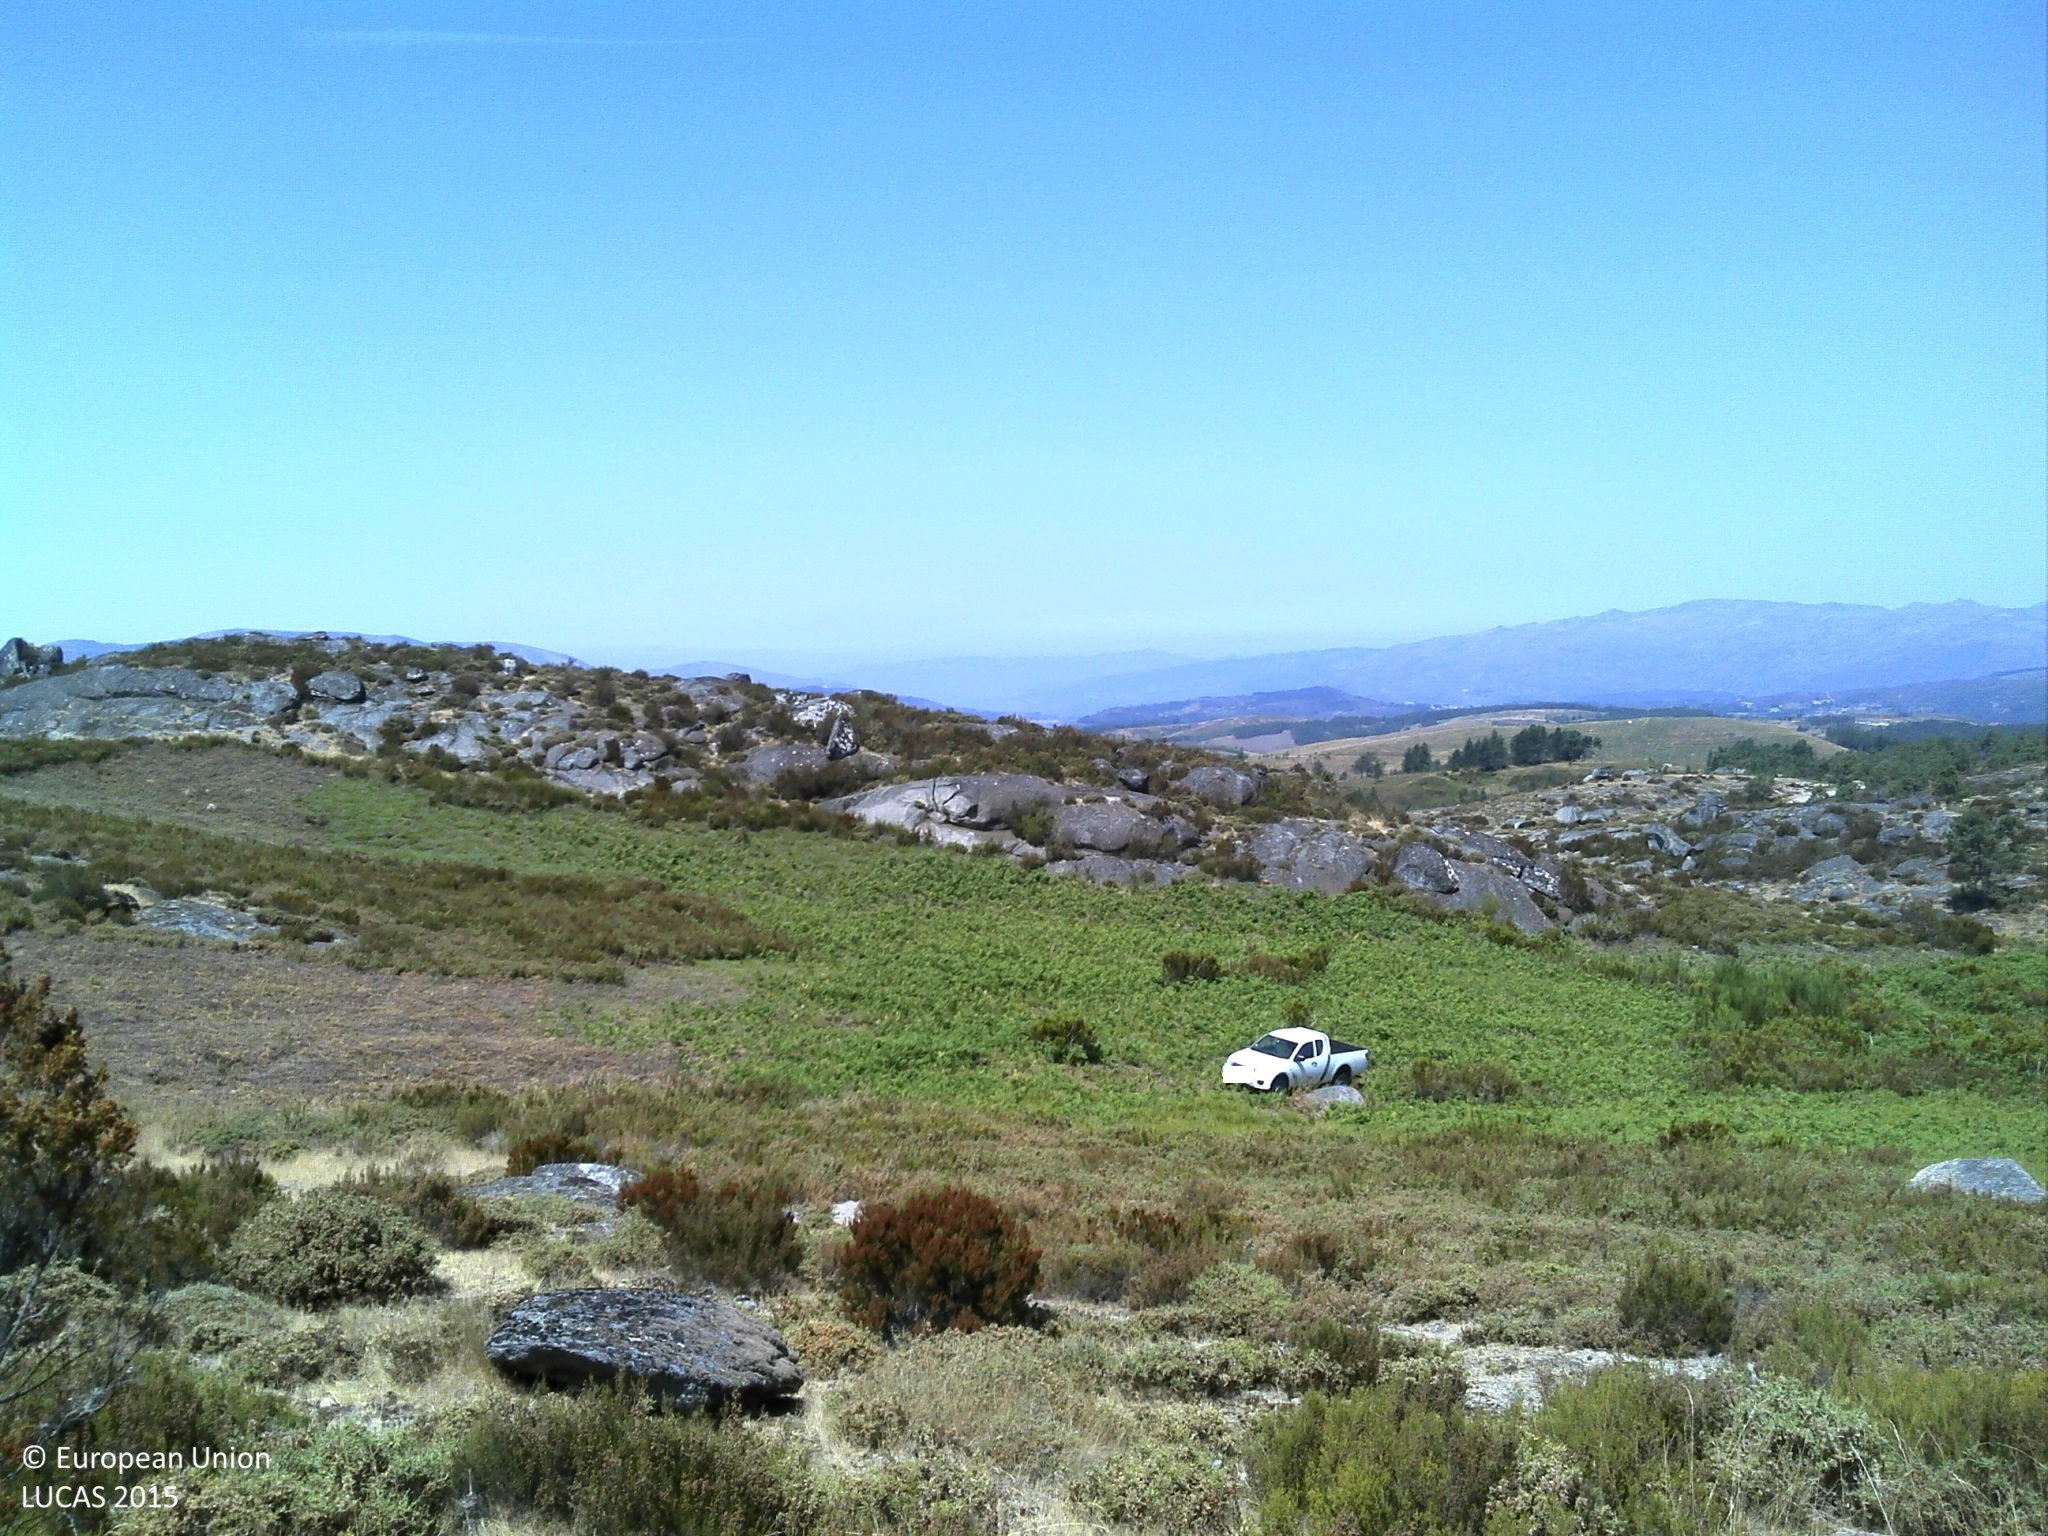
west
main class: Shrubland
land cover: Shrubland without tree cover
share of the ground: > 75 %
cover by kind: shrubs 75 %, consolidated bare surface 25 %
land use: Agriculture (excluding fallow land and kitchen gardens)
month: July
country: PT
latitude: 41.6748
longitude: -7.8817
